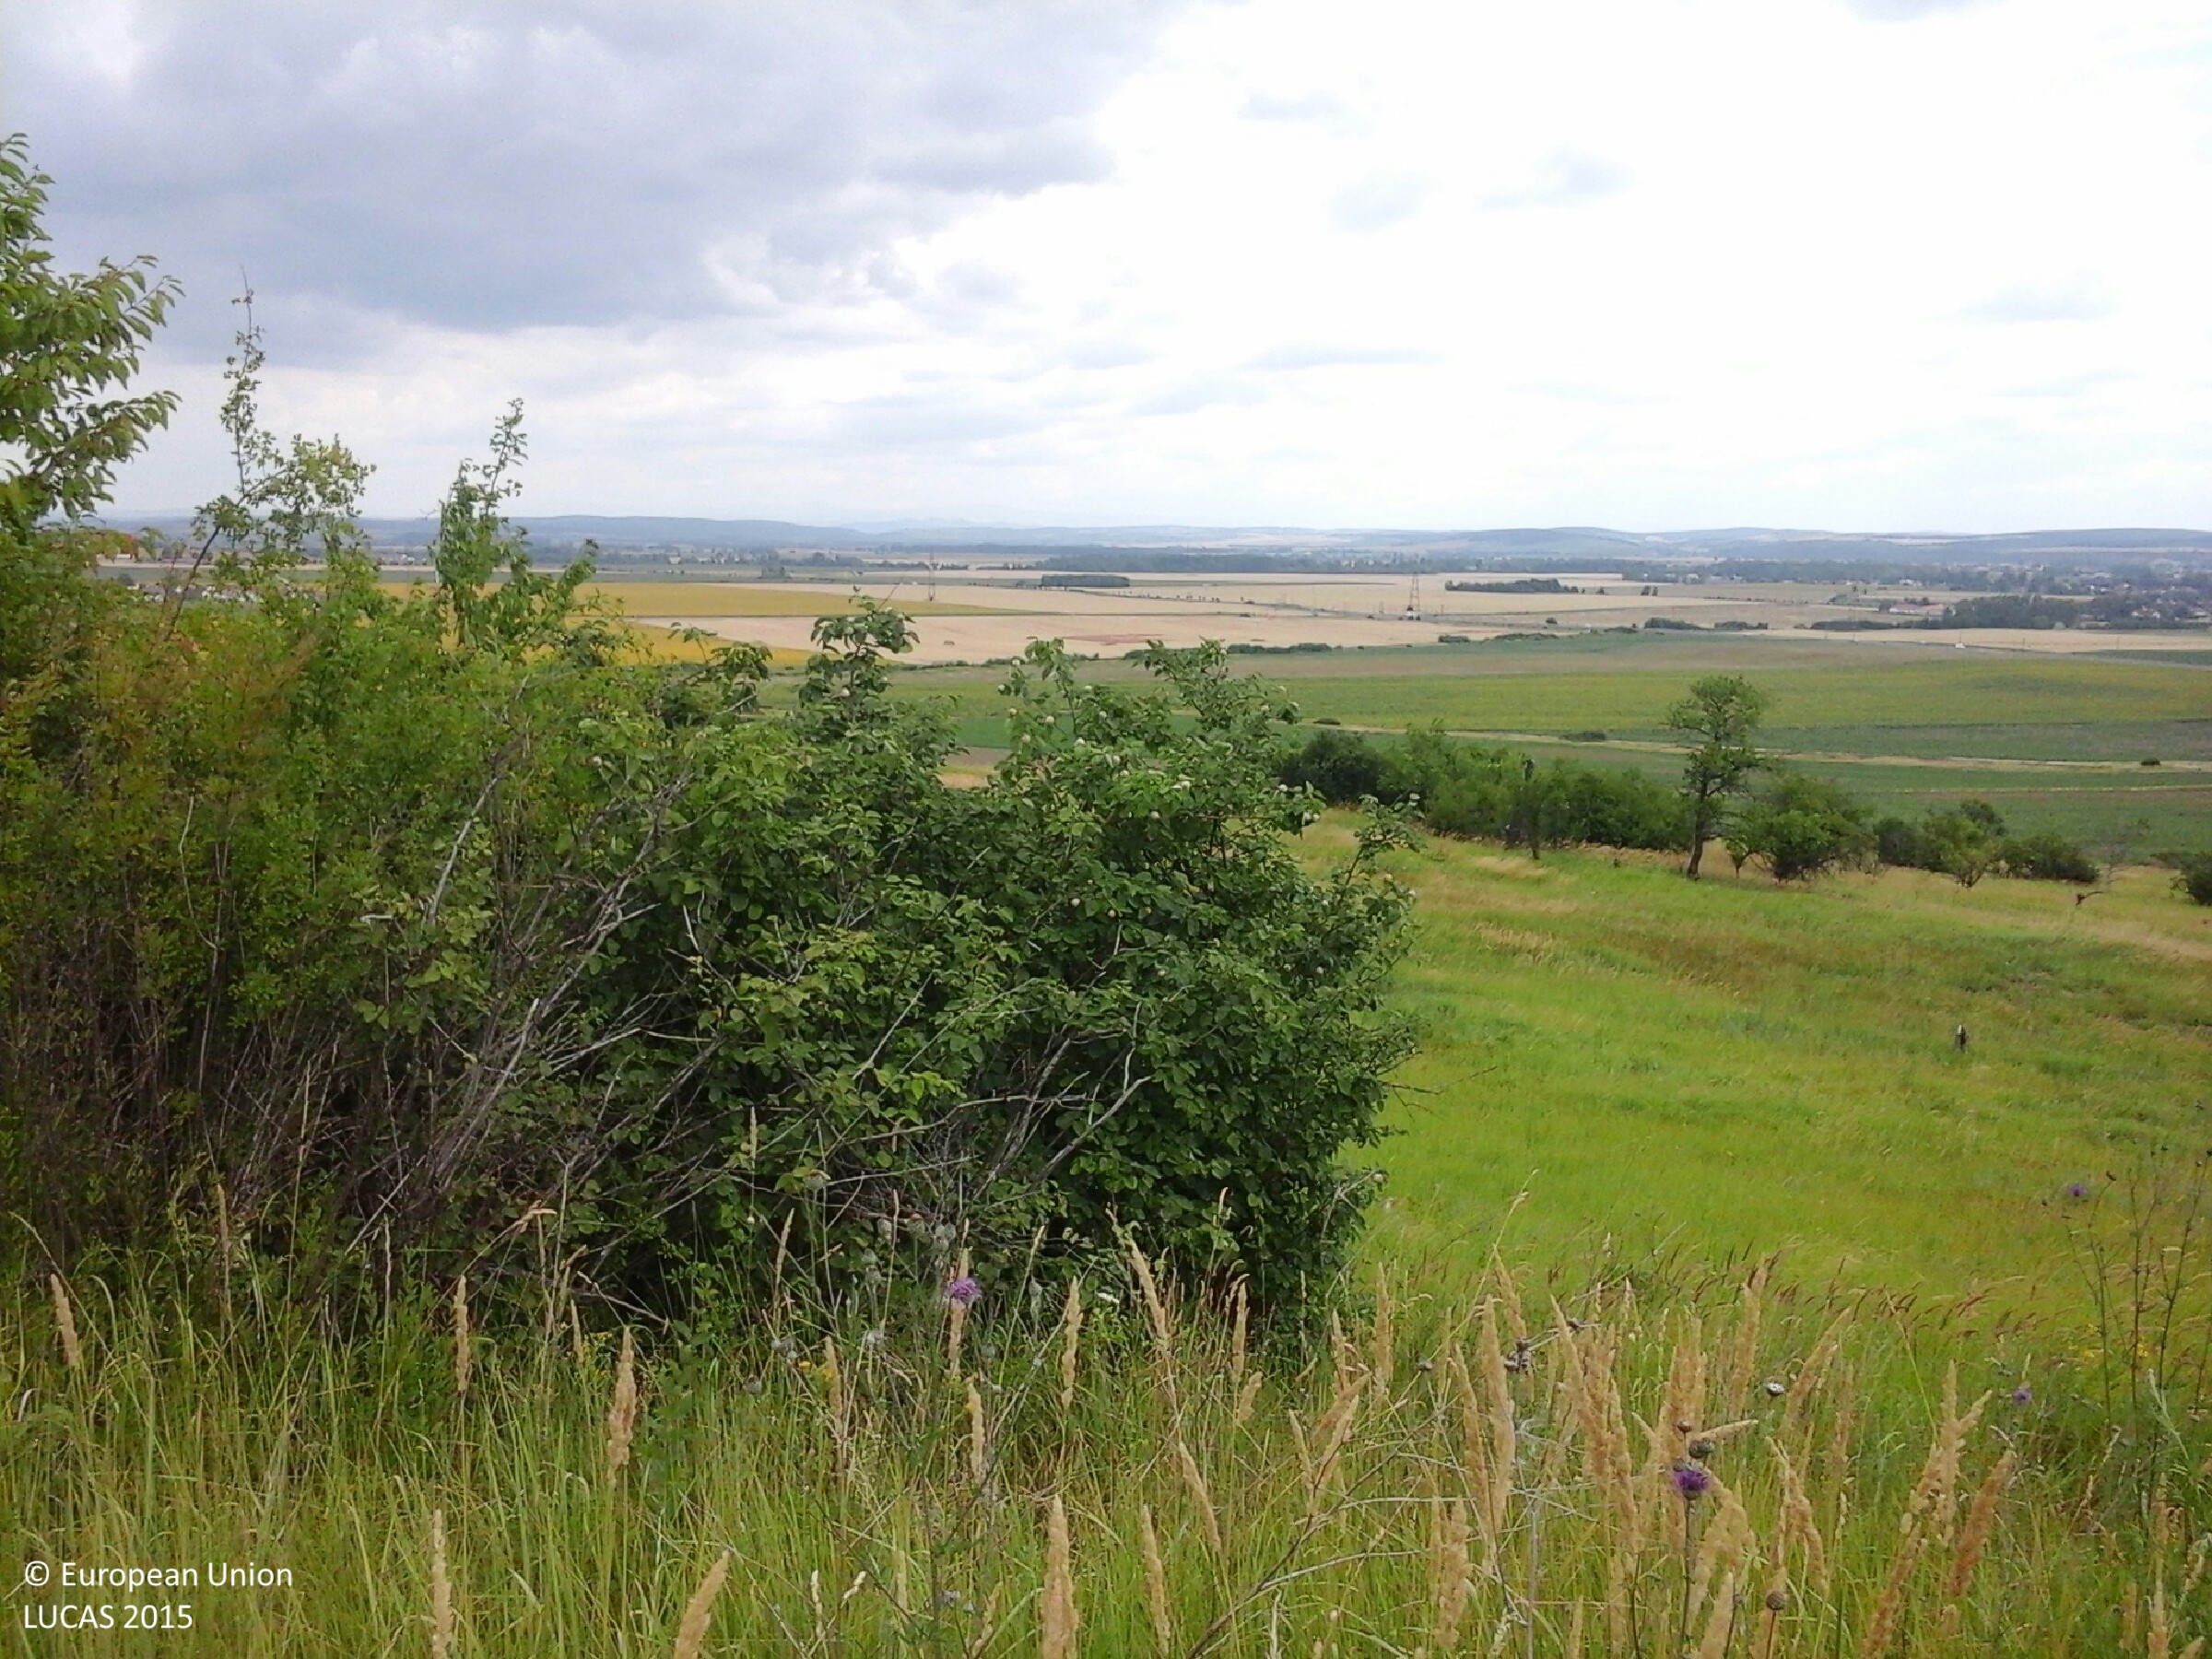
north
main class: Grassland
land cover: Grassland with sparse tree/shrub cover
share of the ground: > 75 %
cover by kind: herbaceous plants 85 %, shrubs 10 %, broadleaved forest trees 5 %
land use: Abandoned areas
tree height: < 5 m
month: July
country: HU
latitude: 48.1679
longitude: 20.7532
